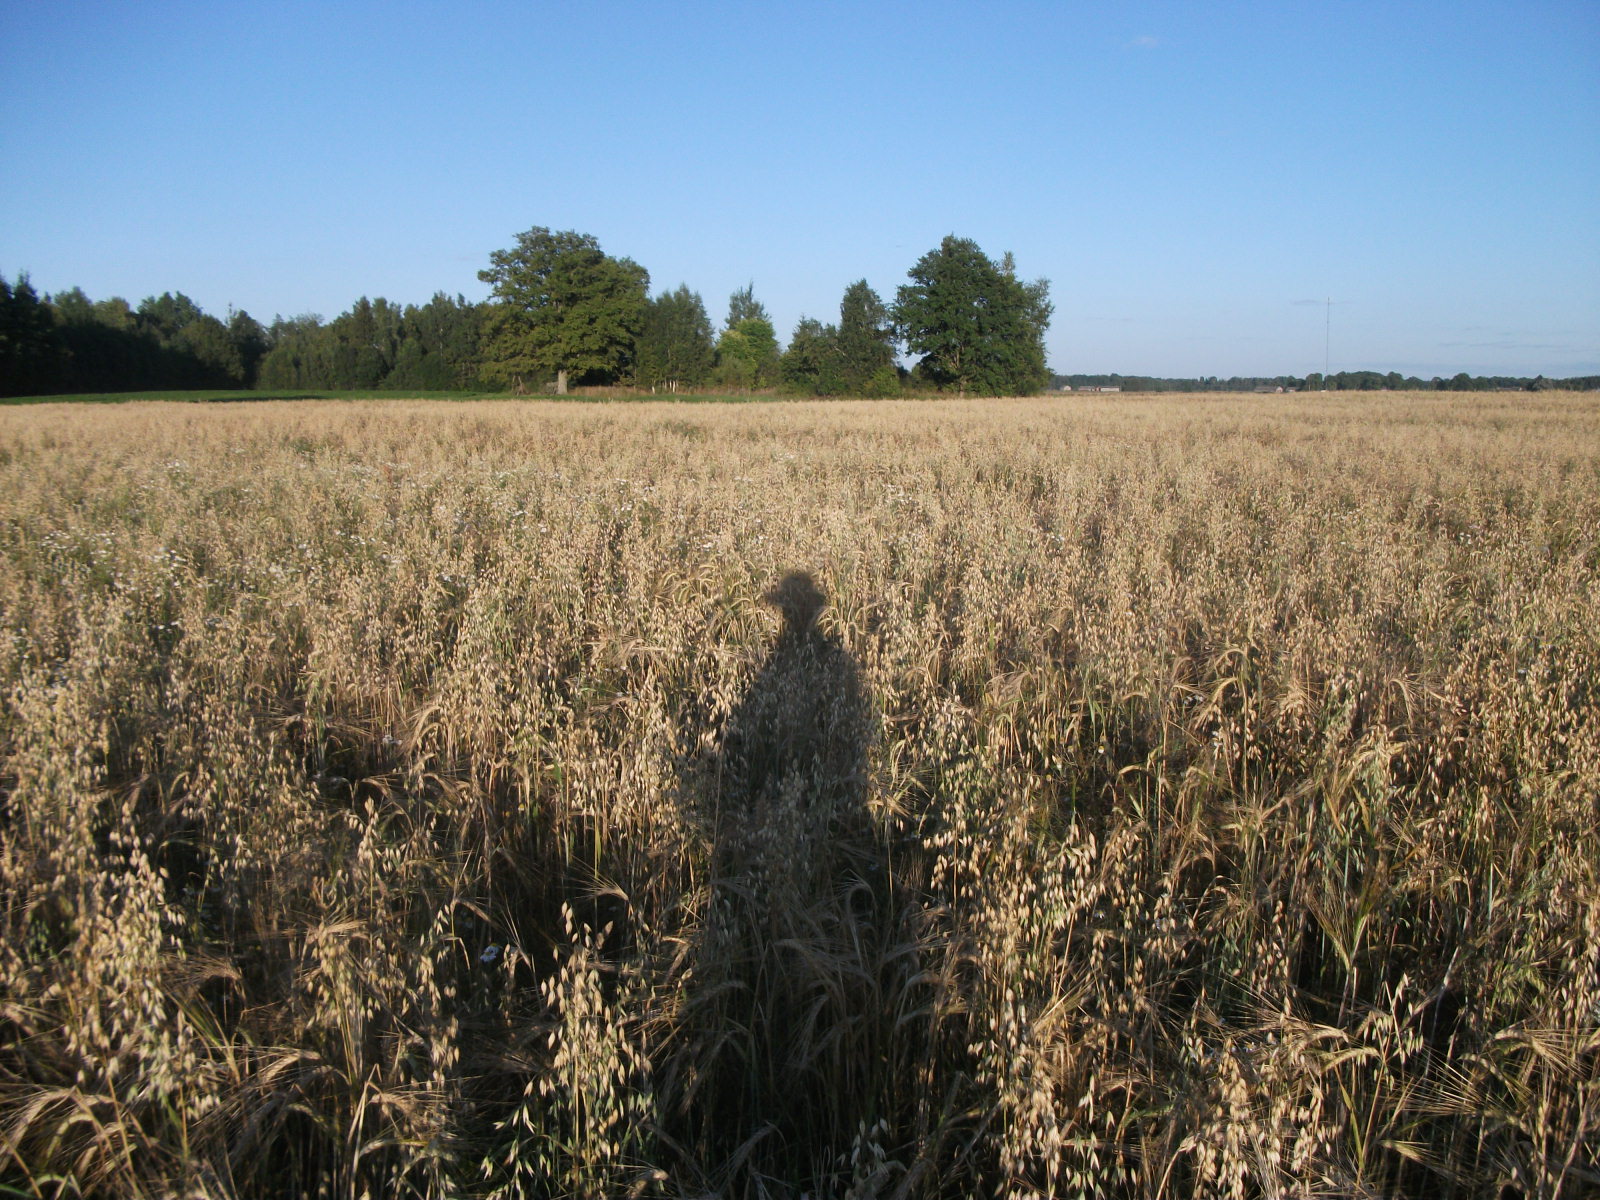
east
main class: Cropland
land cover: Mixed cereals for fodder
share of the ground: 50 - 75 %
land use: Agriculture (excluding fallow land and kitchen gardens)
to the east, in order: Mixed cereals for fodder; Clovers
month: August
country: LV
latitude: 56.3397
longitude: 26.3704
